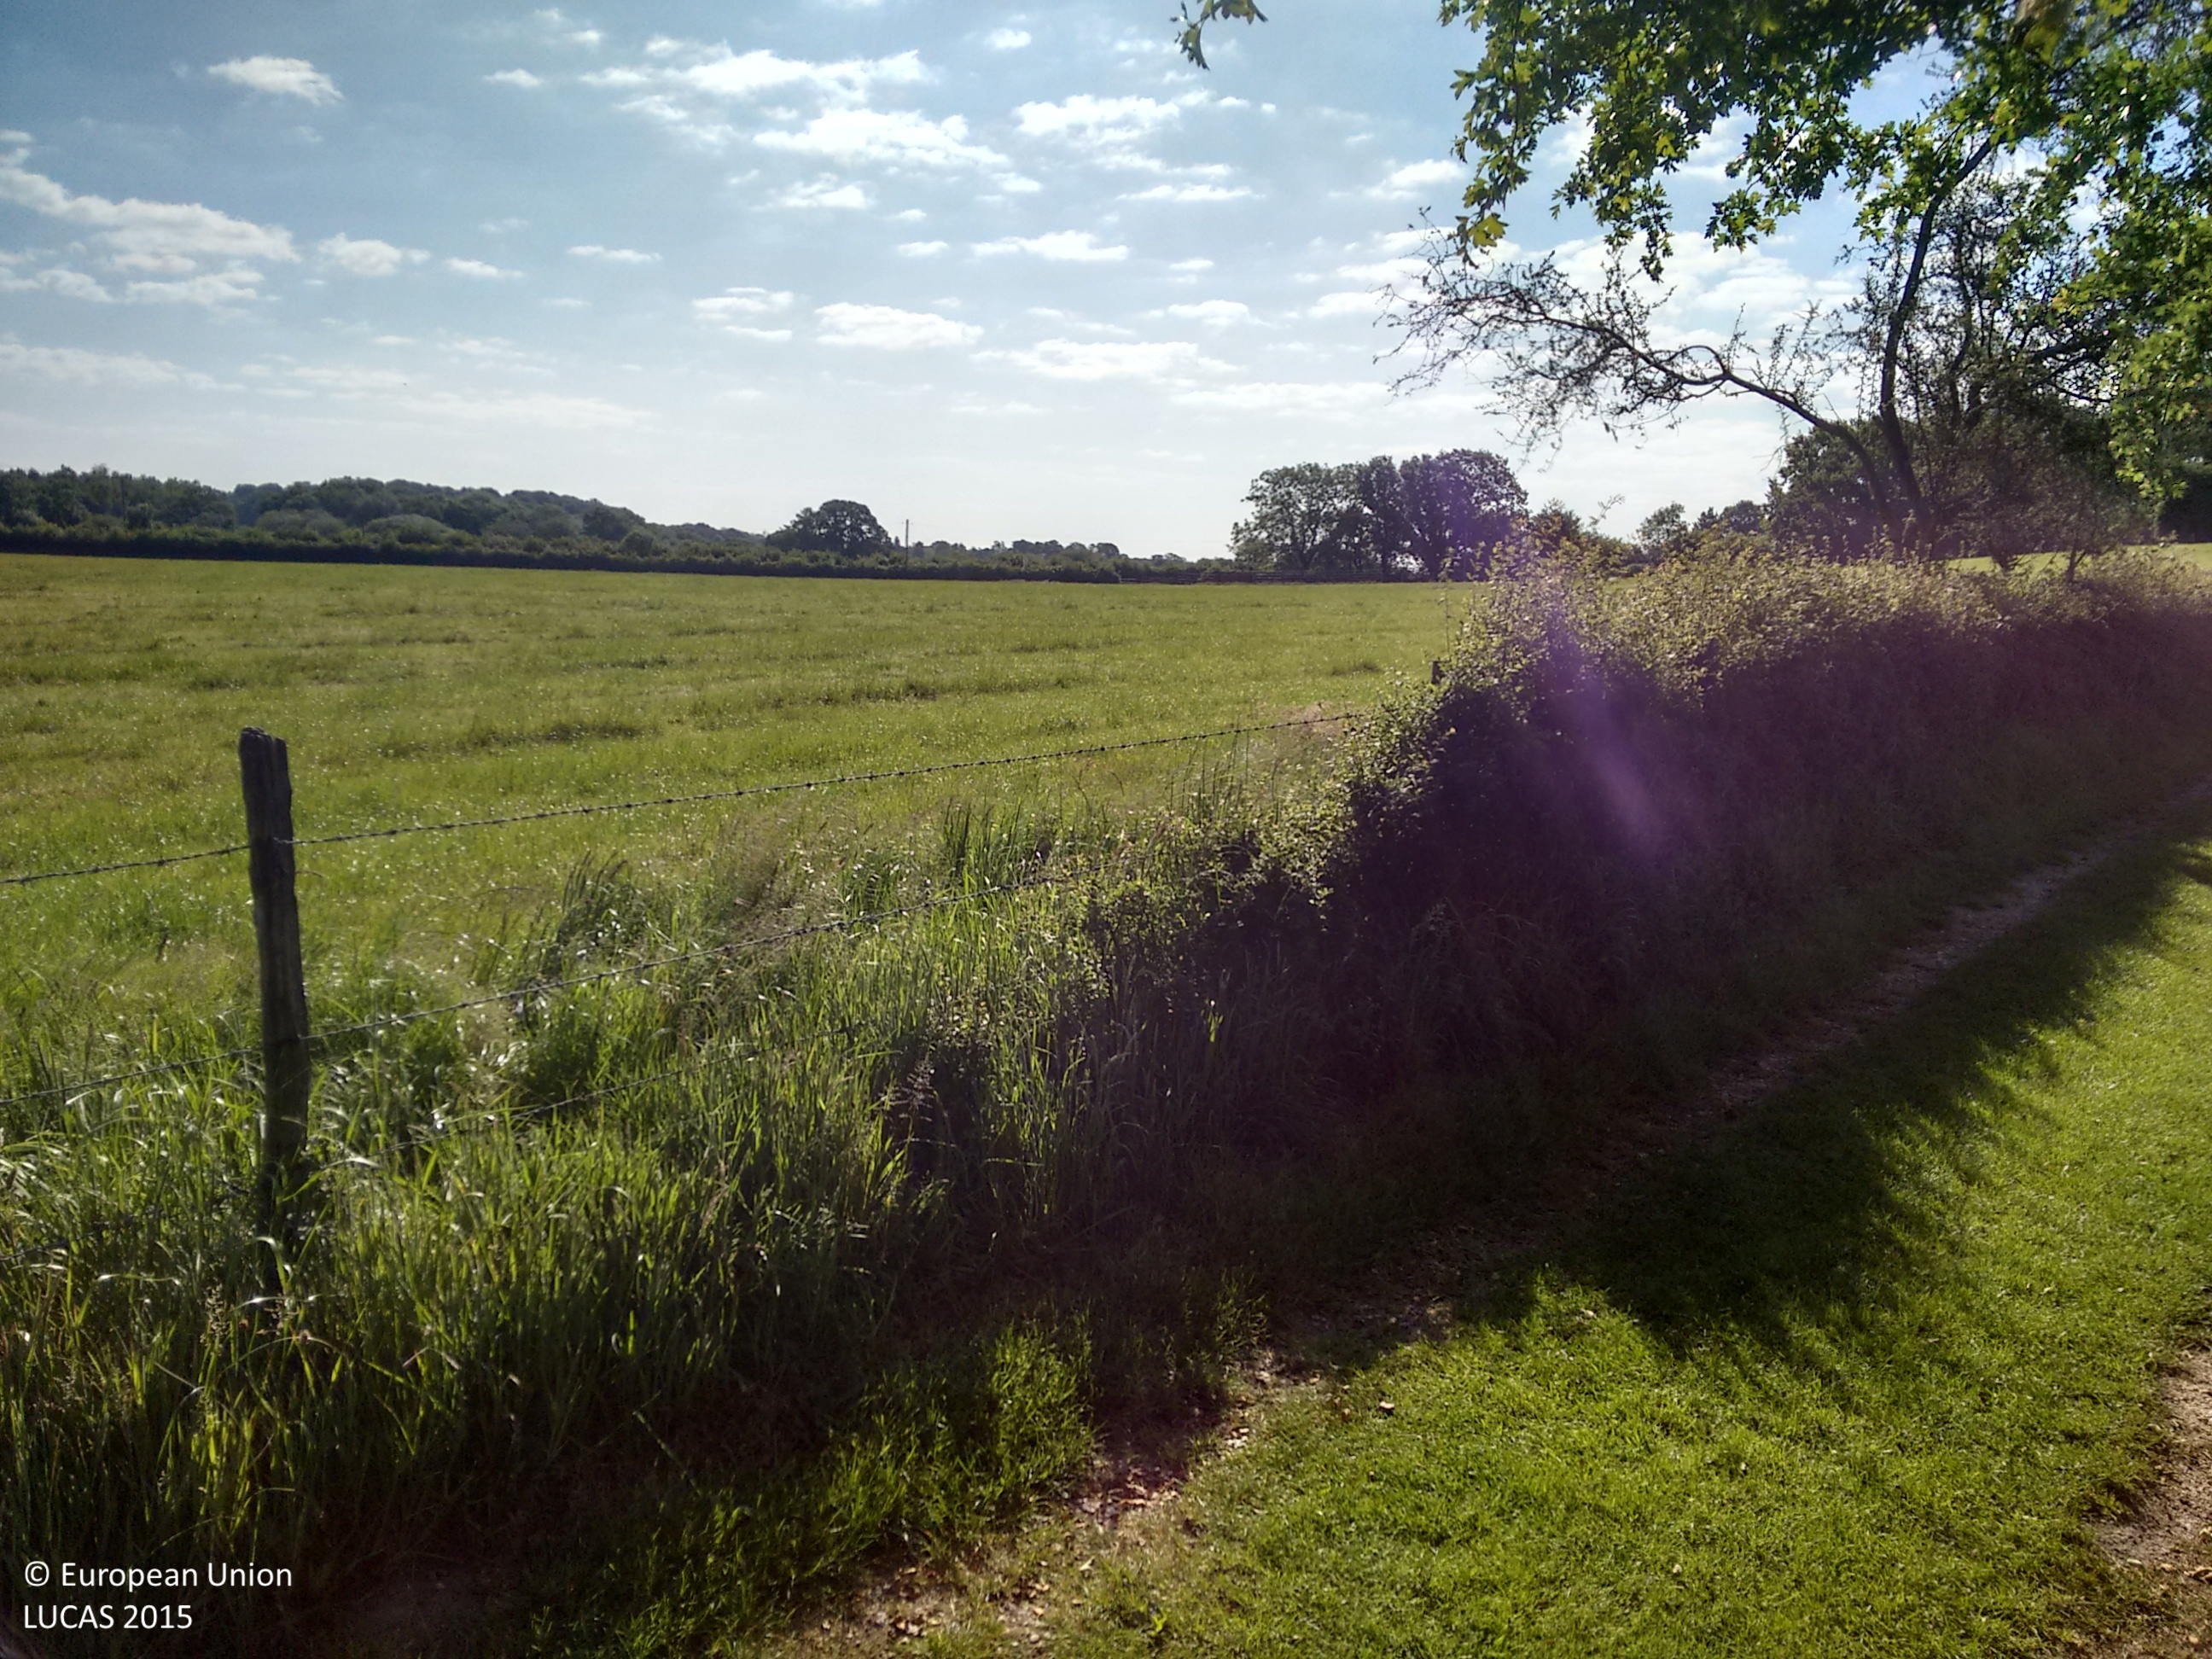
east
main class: Grassland
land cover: Grassland without tree/shrub cover
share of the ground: > 75 %
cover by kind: herbaceous plants 100 %
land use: Agriculture (excluding fallow land and kitchen gardens)
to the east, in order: Grassland without tree/shrub cover; Fences; Tracks; Fences; Grassland without tree/shrub cover; Fences; Managed hedges; Electric lines; Ditches and canals; Grass margins; Paved roads, cycling and walking lanes; Grass margins; Ditches and canals; Managed hedges; Fences; Grassland without tree/shrub cover
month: June
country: GB
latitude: 50.9875
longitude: -1.4326
